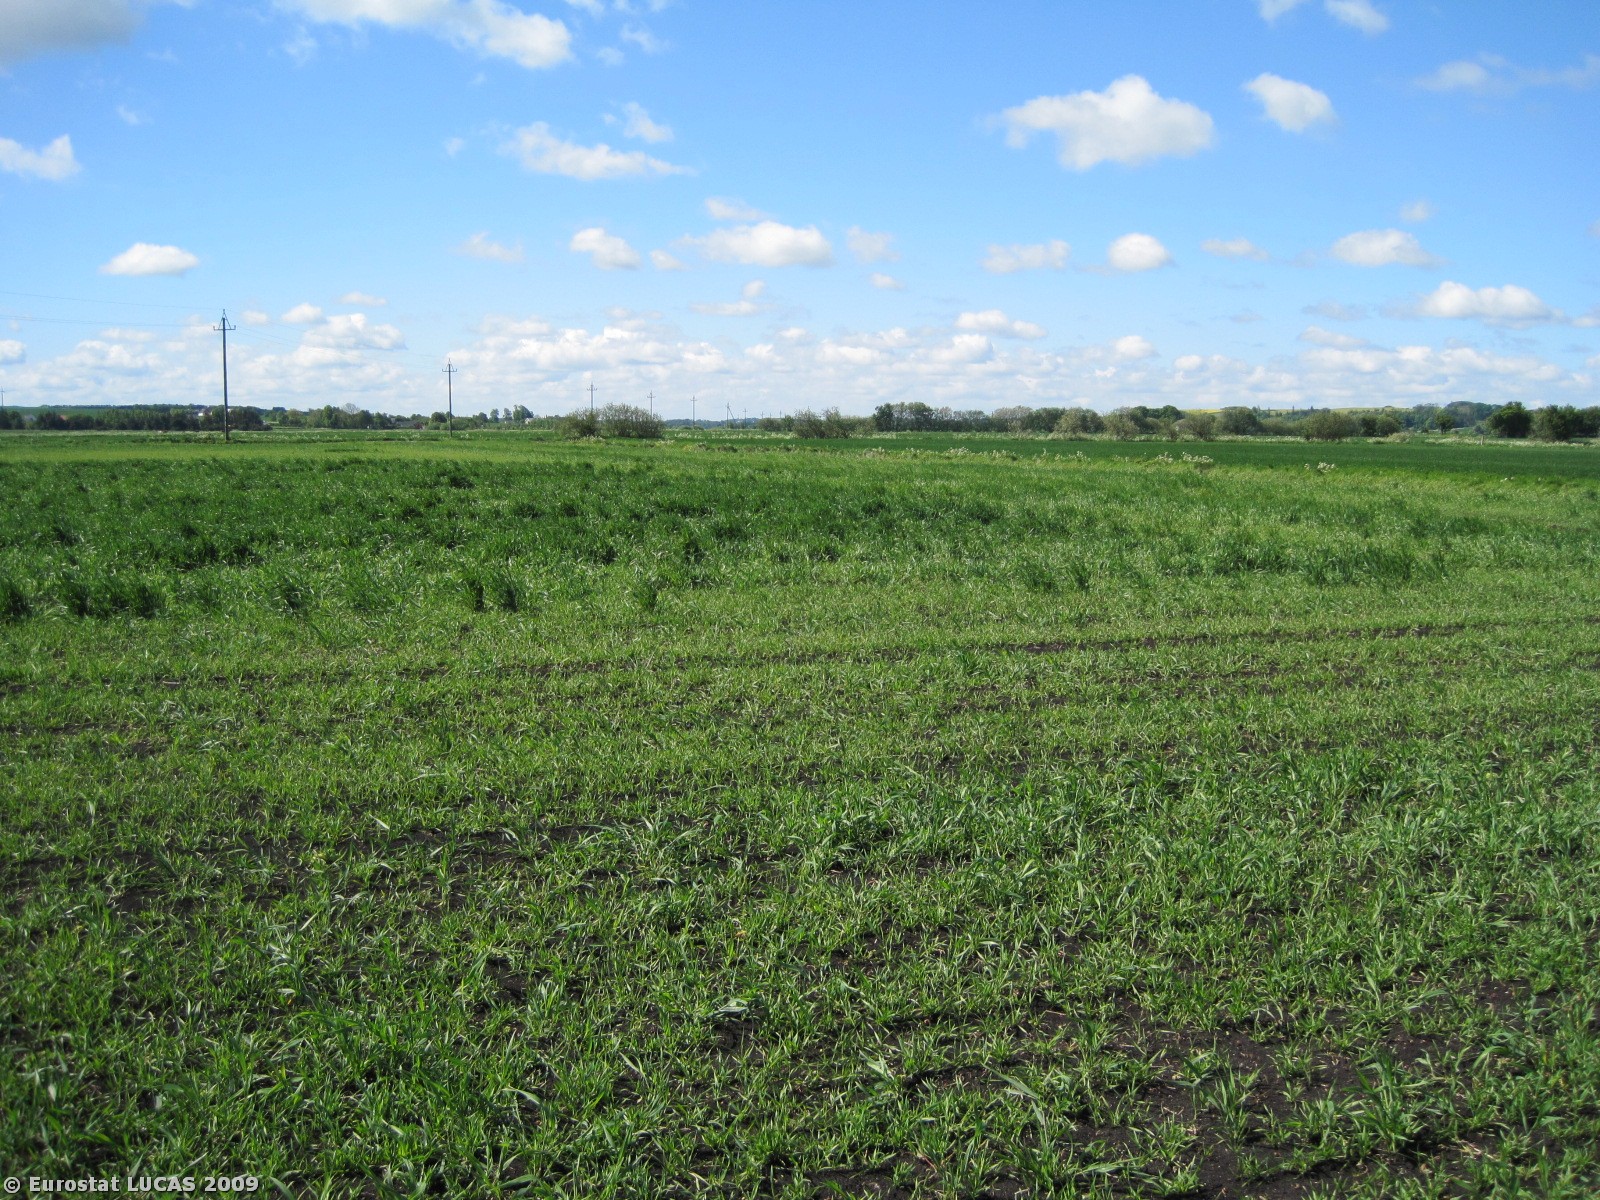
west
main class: Cropland
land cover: Barley
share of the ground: 50 - 75 %
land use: Agriculture (excluding fallow land and kitchen gardens)
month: May
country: DK
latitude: 56.9068
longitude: 10.0820
